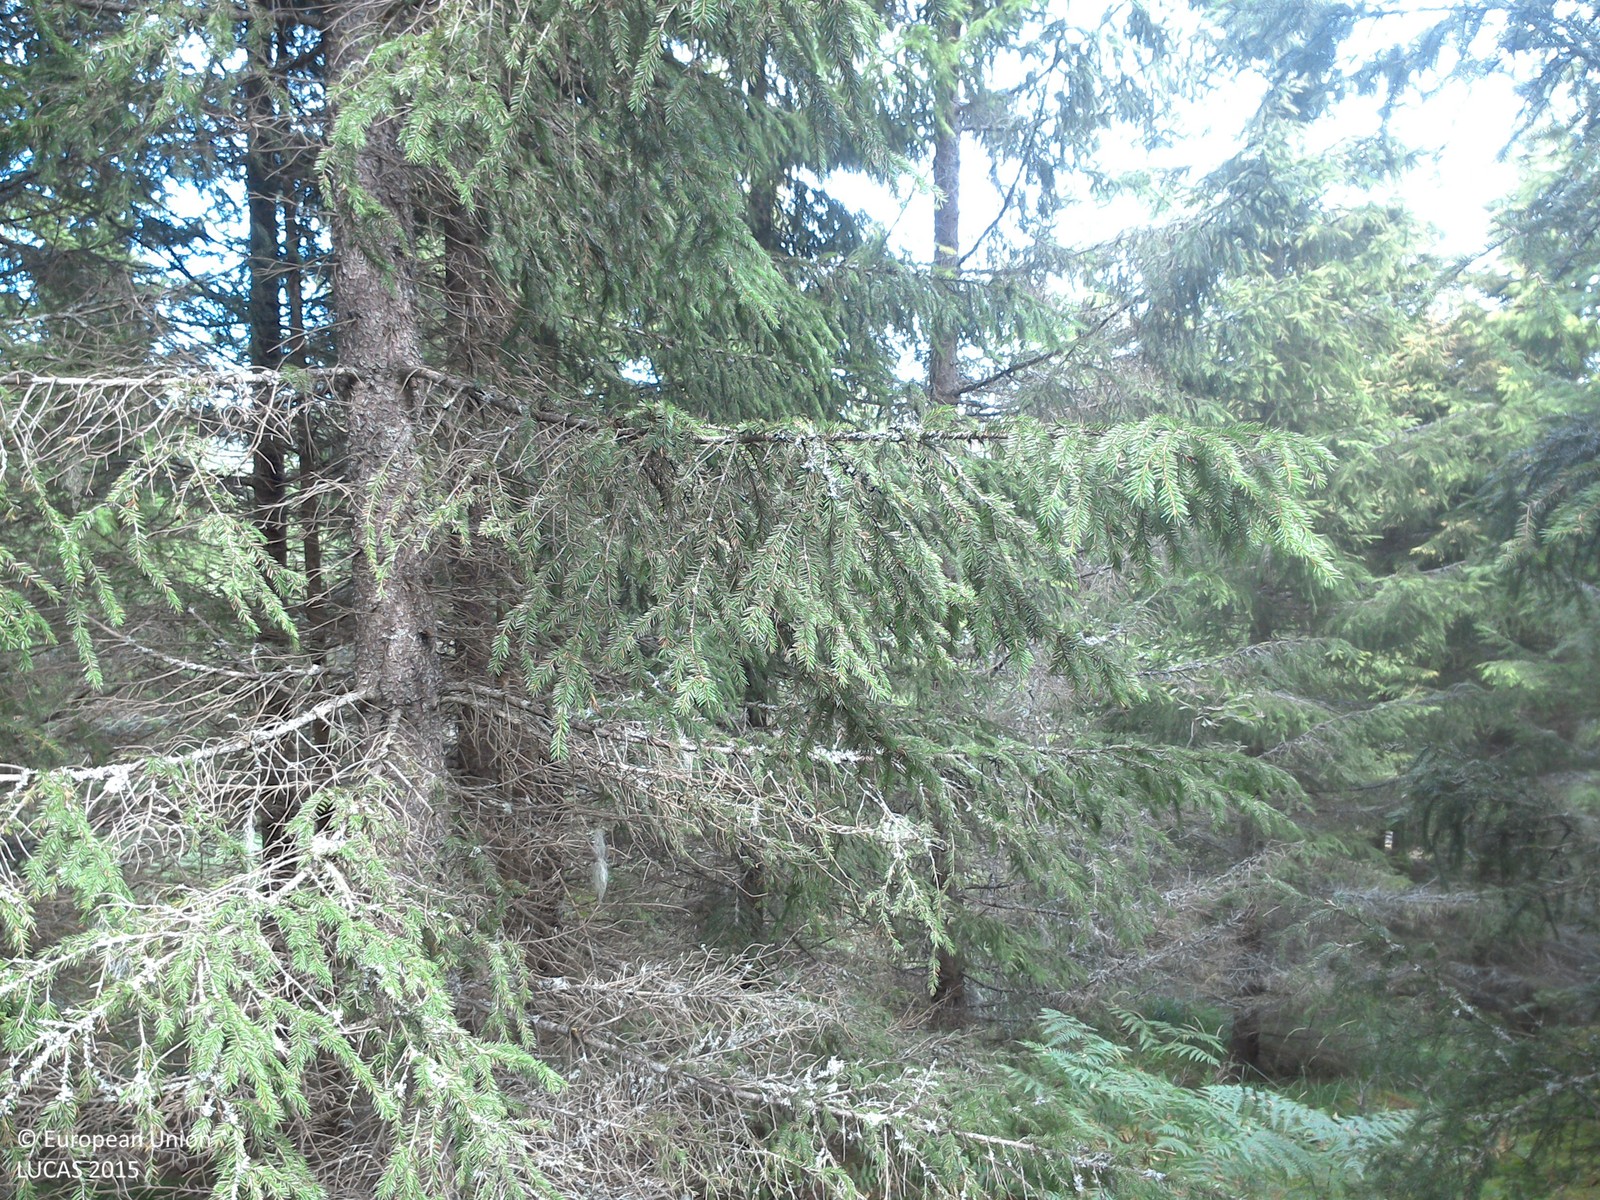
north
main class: Woodland
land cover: Spruce dominated coniferous woodland
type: boreal forest
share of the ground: 50 - 75 %
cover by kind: coniferous forest trees 55 %, lichens and mosses 30 %, herbaceous plants 15 %
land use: Forestry
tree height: > 5 m
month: August
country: SE
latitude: 57.8543
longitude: 15.5061
